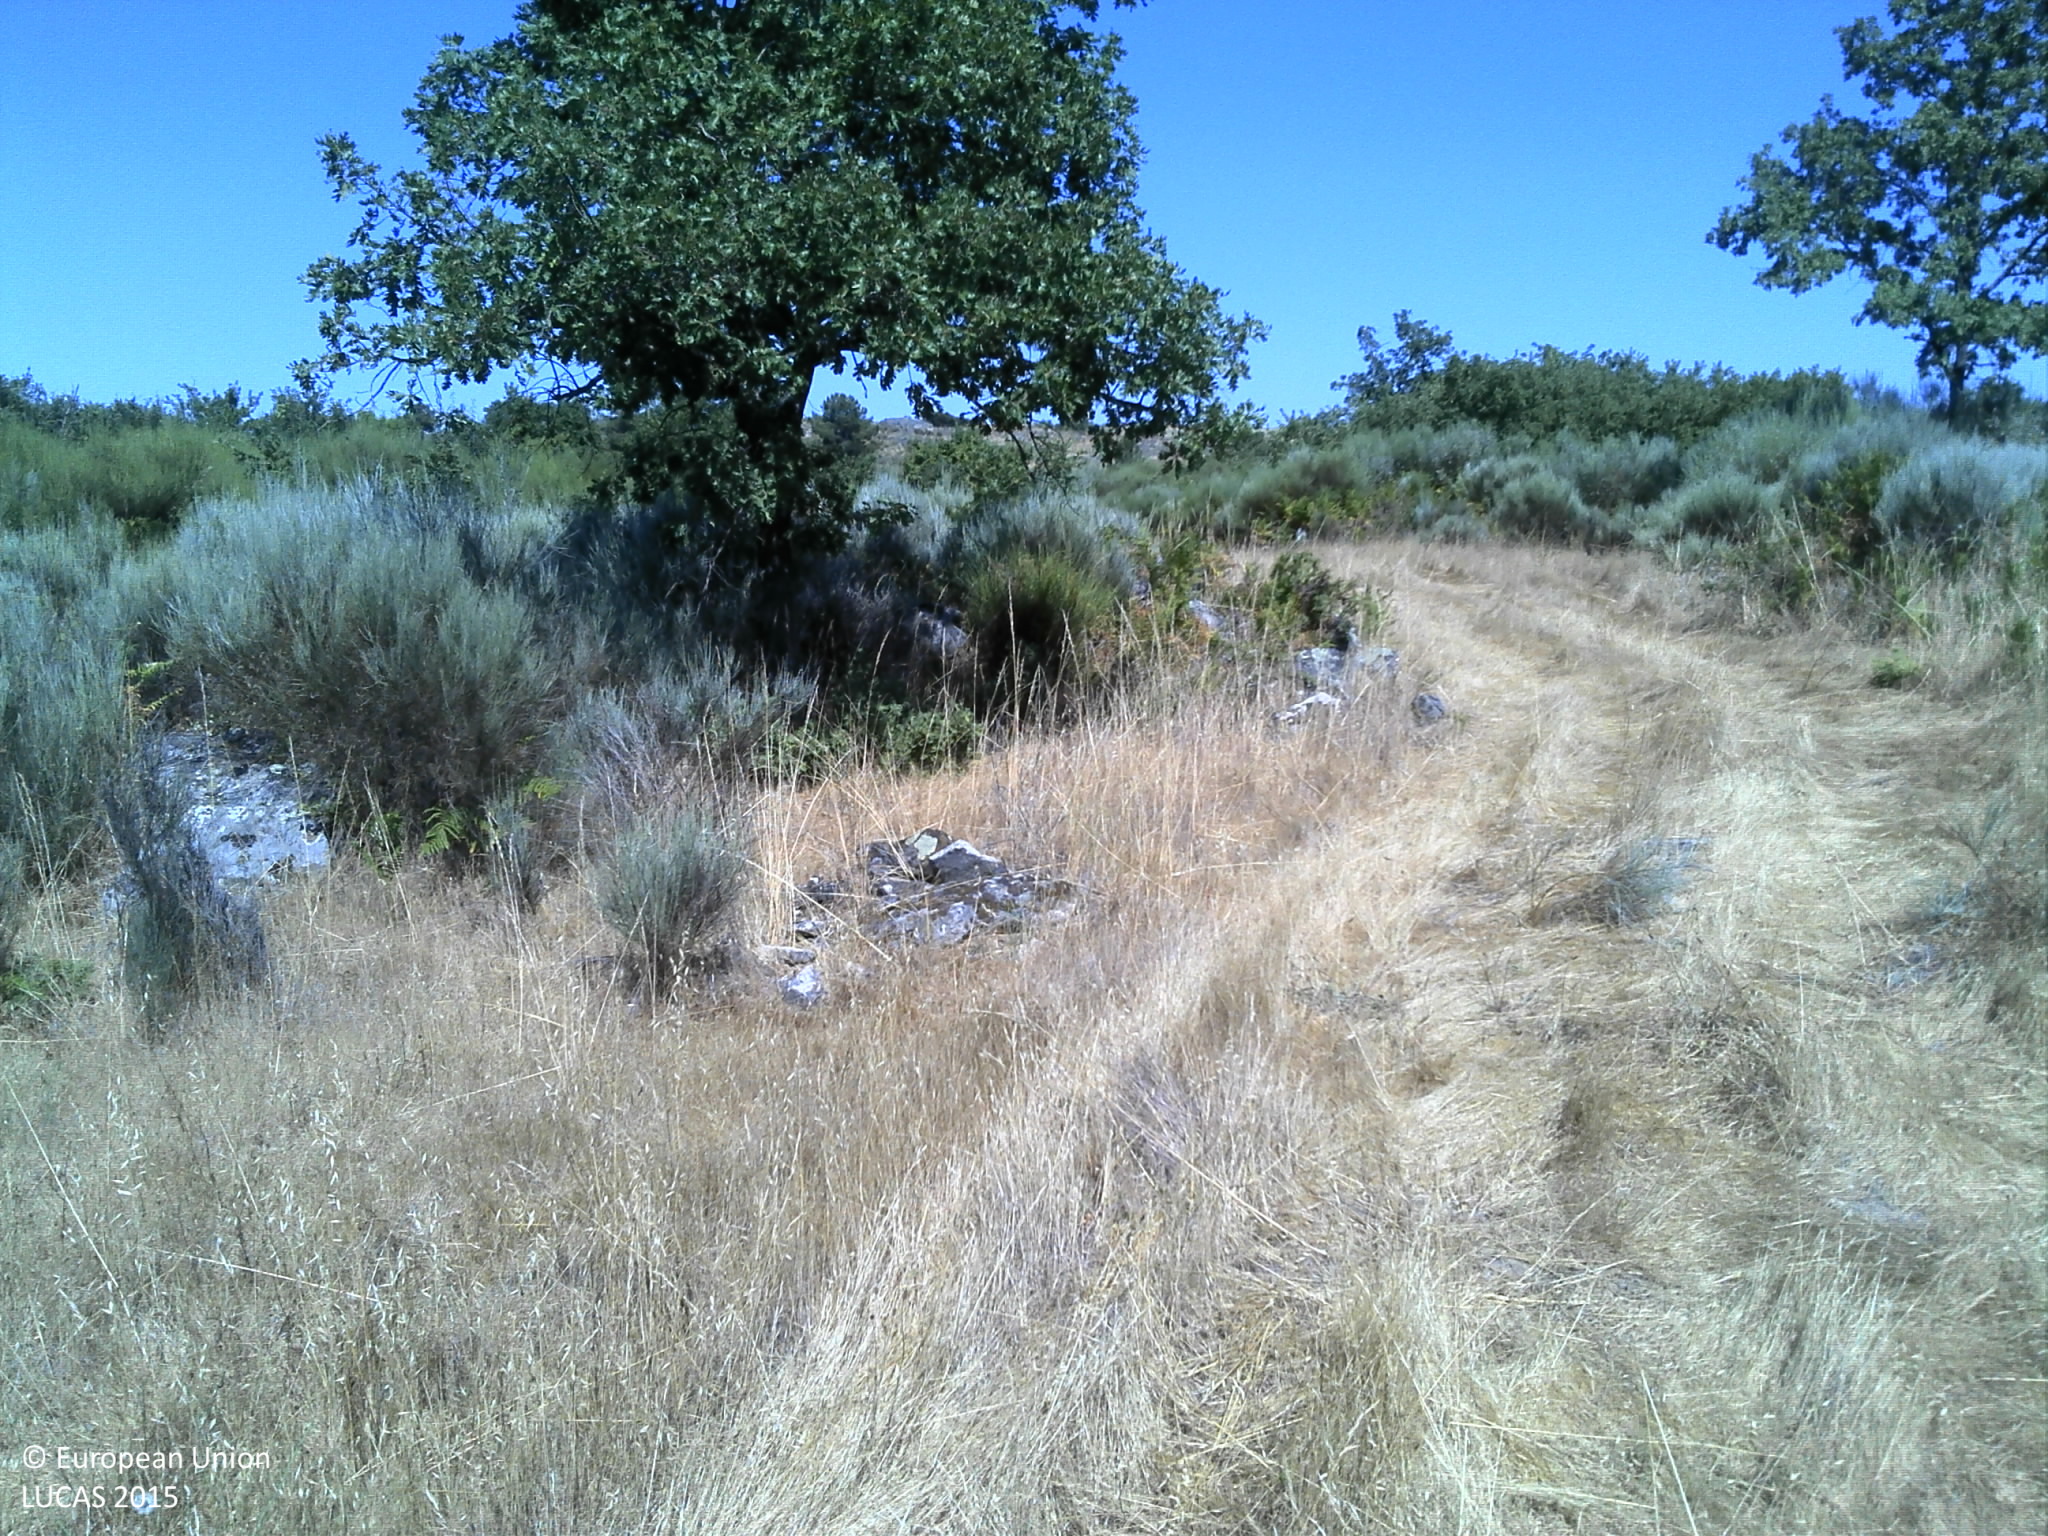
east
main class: Grassland
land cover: Grassland without tree/shrub cover
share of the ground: > 75 %
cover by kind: herbaceous plants 95 %, shrubs 5 %
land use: Agriculture (excluding fallow land and kitchen gardens)
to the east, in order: Grassland without tree/shrub cover; Shrubland with sparse tree cover; Grassland without tree/shrub cover; Shruby margins; Rivers and streams; Shruby margins; Apple fruit; Dry stone walls; Vineyards; Dry stone walls; Tracks; Dry stone walls; Vineyards; Other bare soil; Vineyards; Potatoes; Other bare soil; Grassland with sparse tree/shrub cover; Shrubland with sparse tree cover
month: July
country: PT
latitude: 40.9704
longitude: -7.2845
